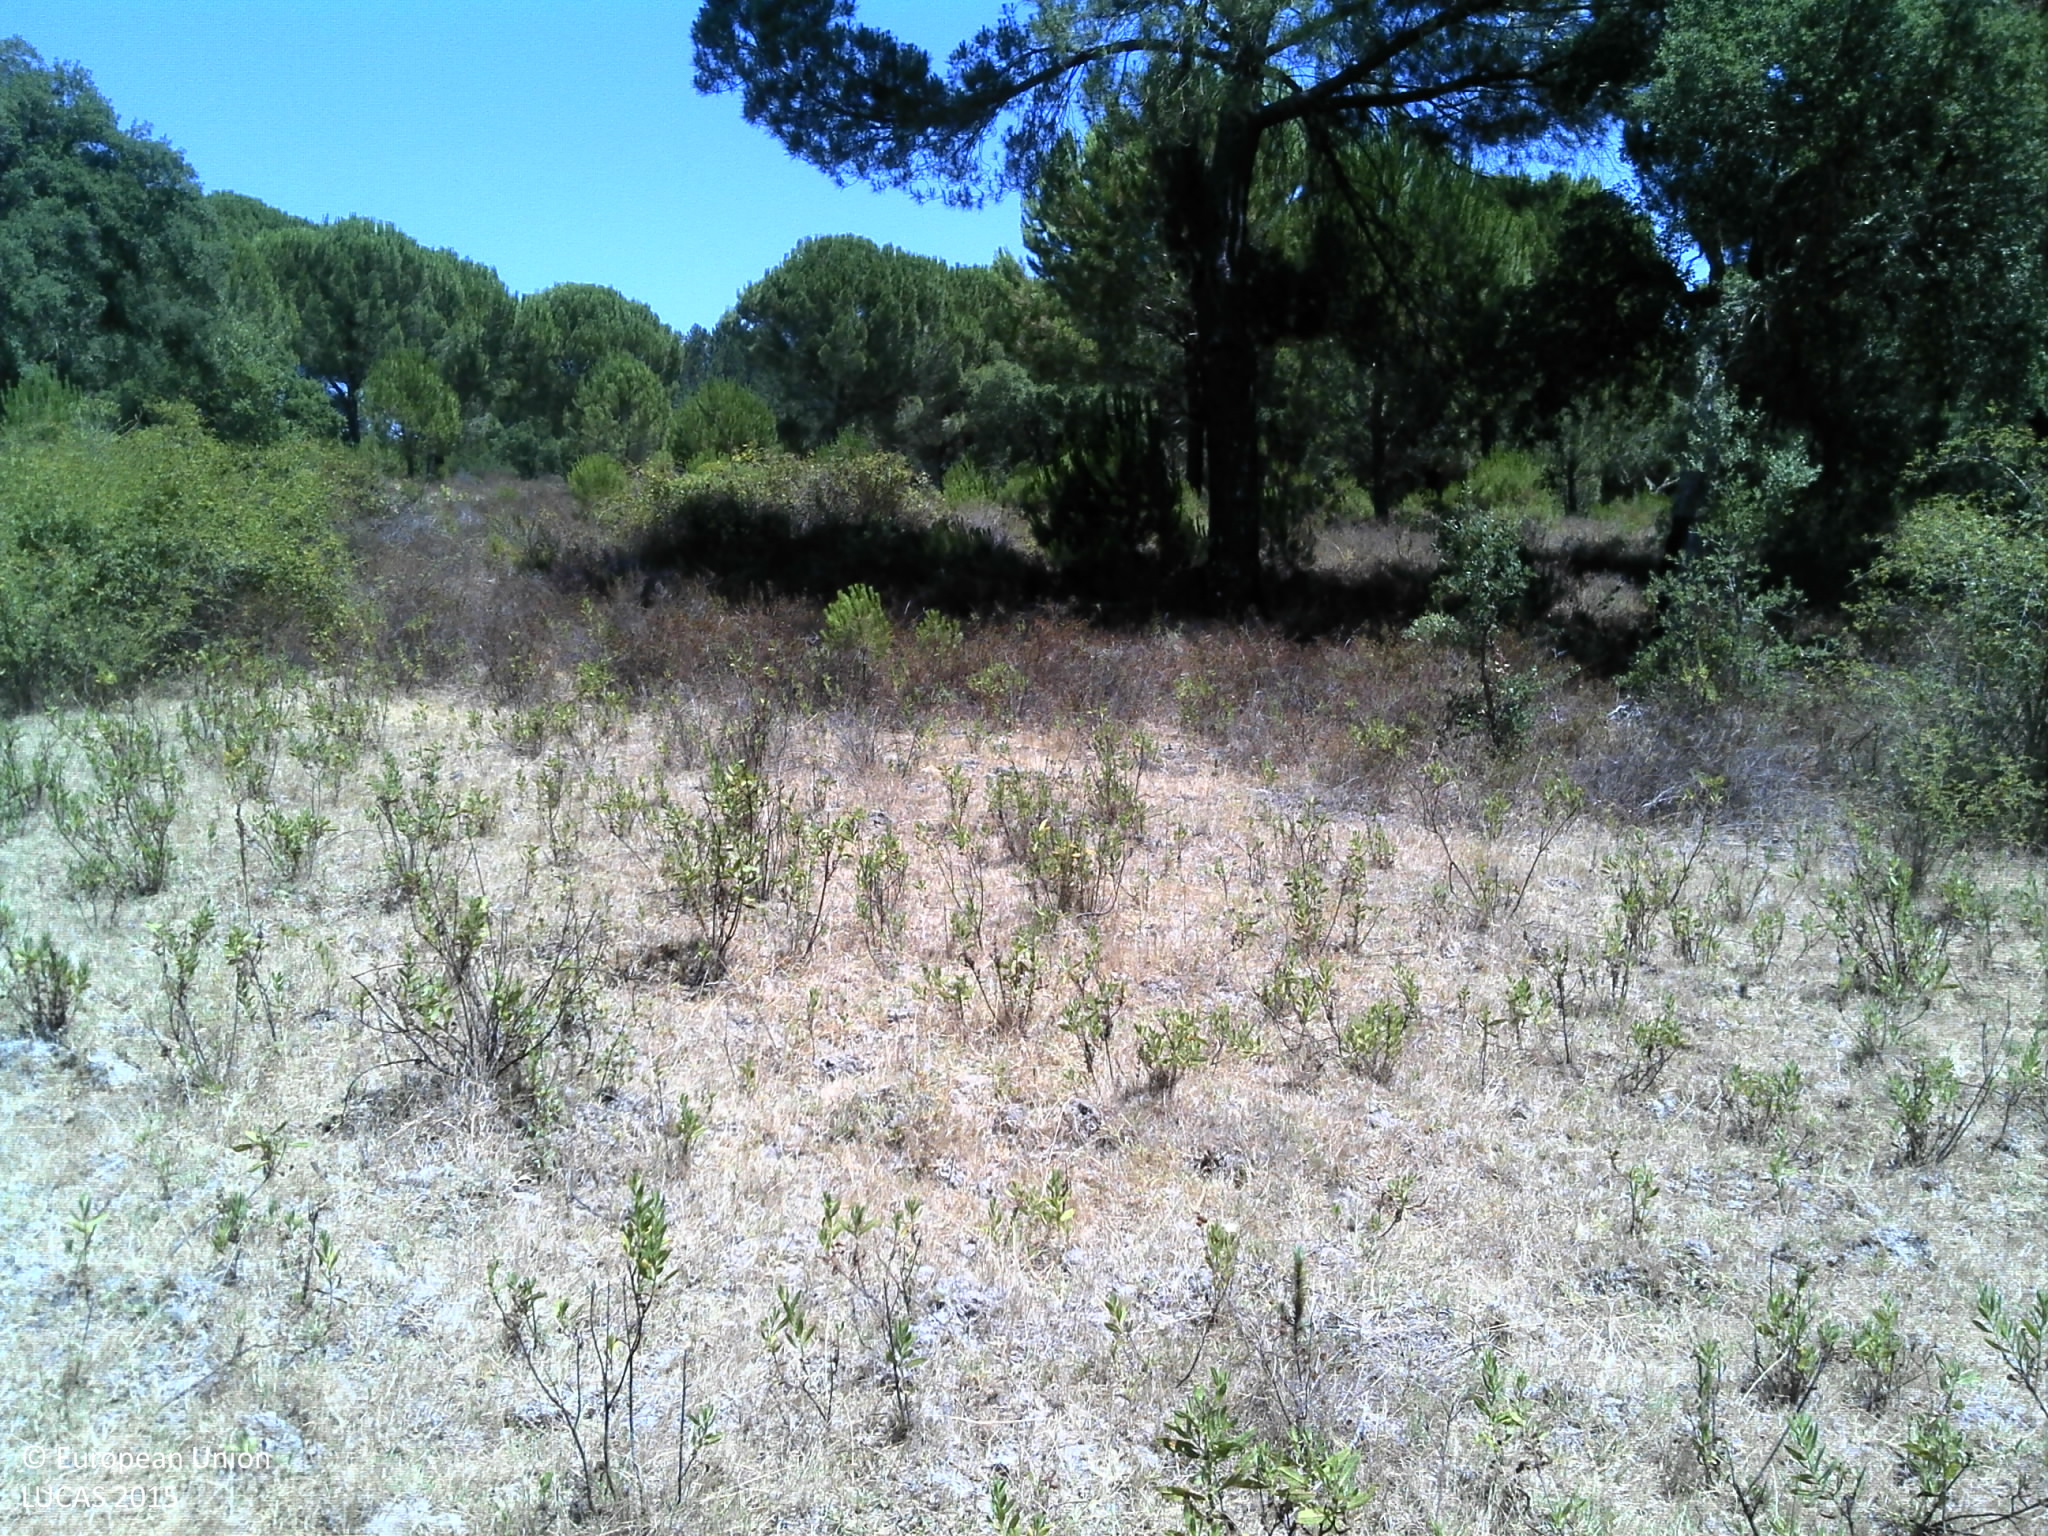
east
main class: Woodland
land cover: Pine dominated mixed woodland
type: coniferous forest of the mediterranean region
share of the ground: 10 - 25 %
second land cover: Shrubland without tree cover
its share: 10 - 25 %
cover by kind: herbaceous plants 30 %, unconsolidated bare surface 30 %, coniferous forest trees 15 %, shrubs 15 %, broadleaved forest trees 10 %
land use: Forestry
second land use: Agriculture (excluding fallow land and kitchen gardens)
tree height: > 5 m
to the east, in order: Pine dominated mixed woodland; Shrubland without tree cover; Pine dominated coniferous woodland; Pine dominated mixed woodland; Pine dominated coniferous woodland; Shrubland with sparse tree cover; Pine dominated mixed woodland; Broadleaved woodland; Fences; Rivers and streams; Pine dominated coniferous woodland
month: July
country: PT
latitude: 38.5738
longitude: -8.5470
